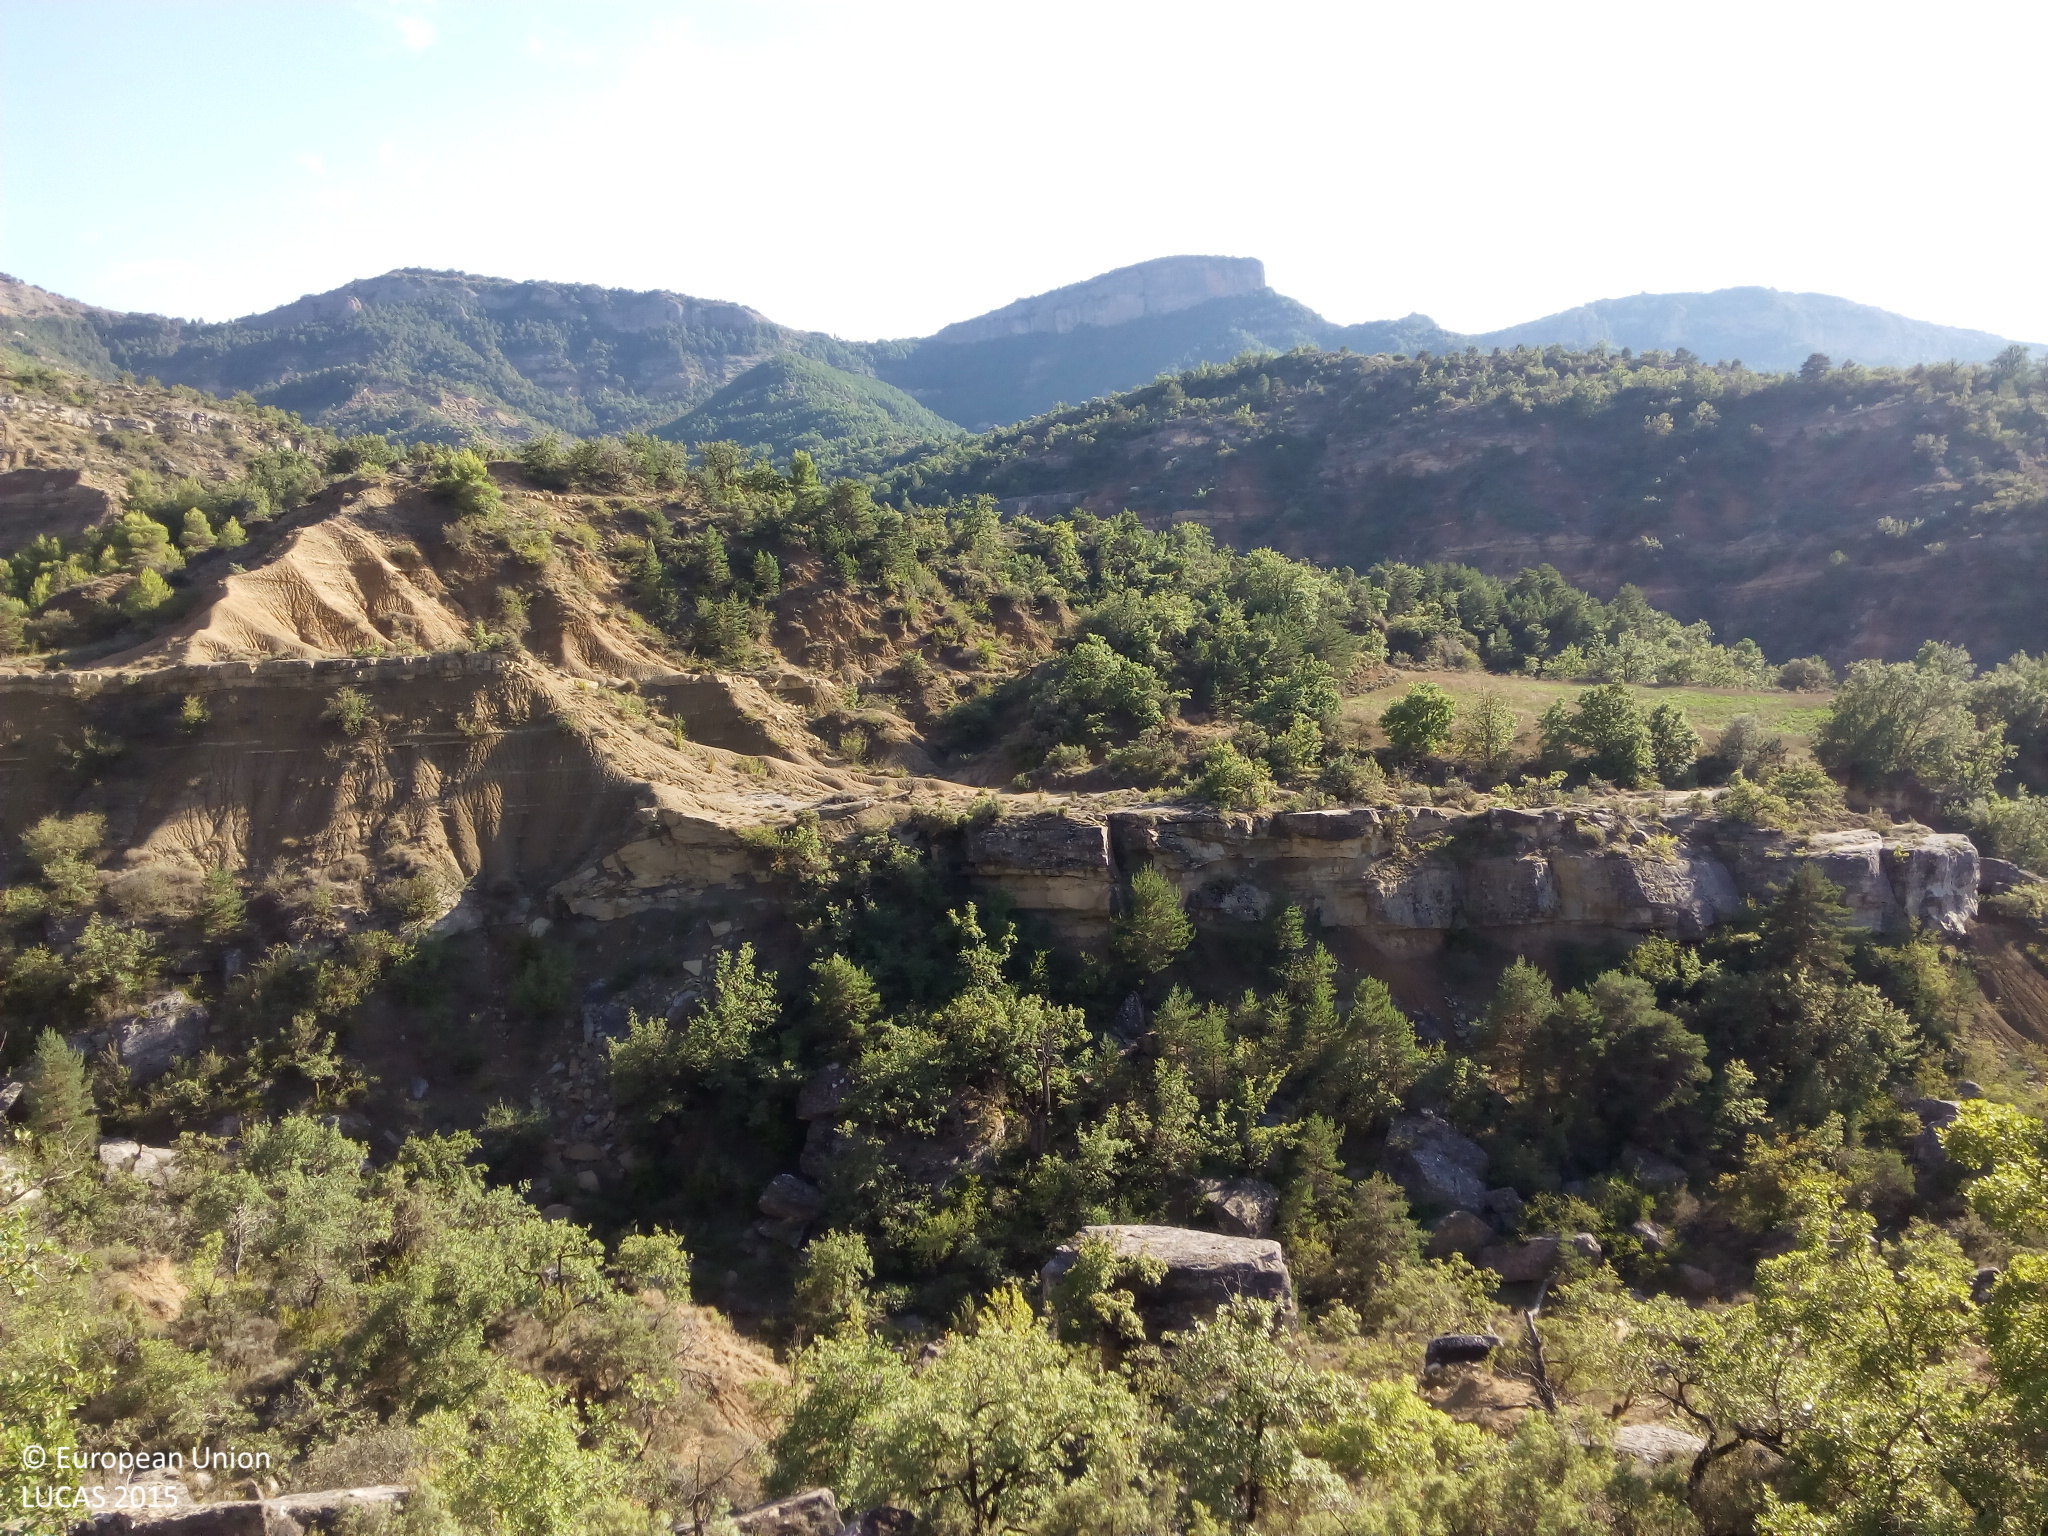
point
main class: Shrubland
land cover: Shrubland with sparse tree cover
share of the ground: > 75 %
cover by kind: consolidated bare surface 50 %, unconsolidated bare surface 30 %, shrubs 15 %, broadleaved forest trees 5 %
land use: Semi-natural and natural areas not in use
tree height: < 5 m
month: August
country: ES
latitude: 42.1840
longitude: 0.4536
